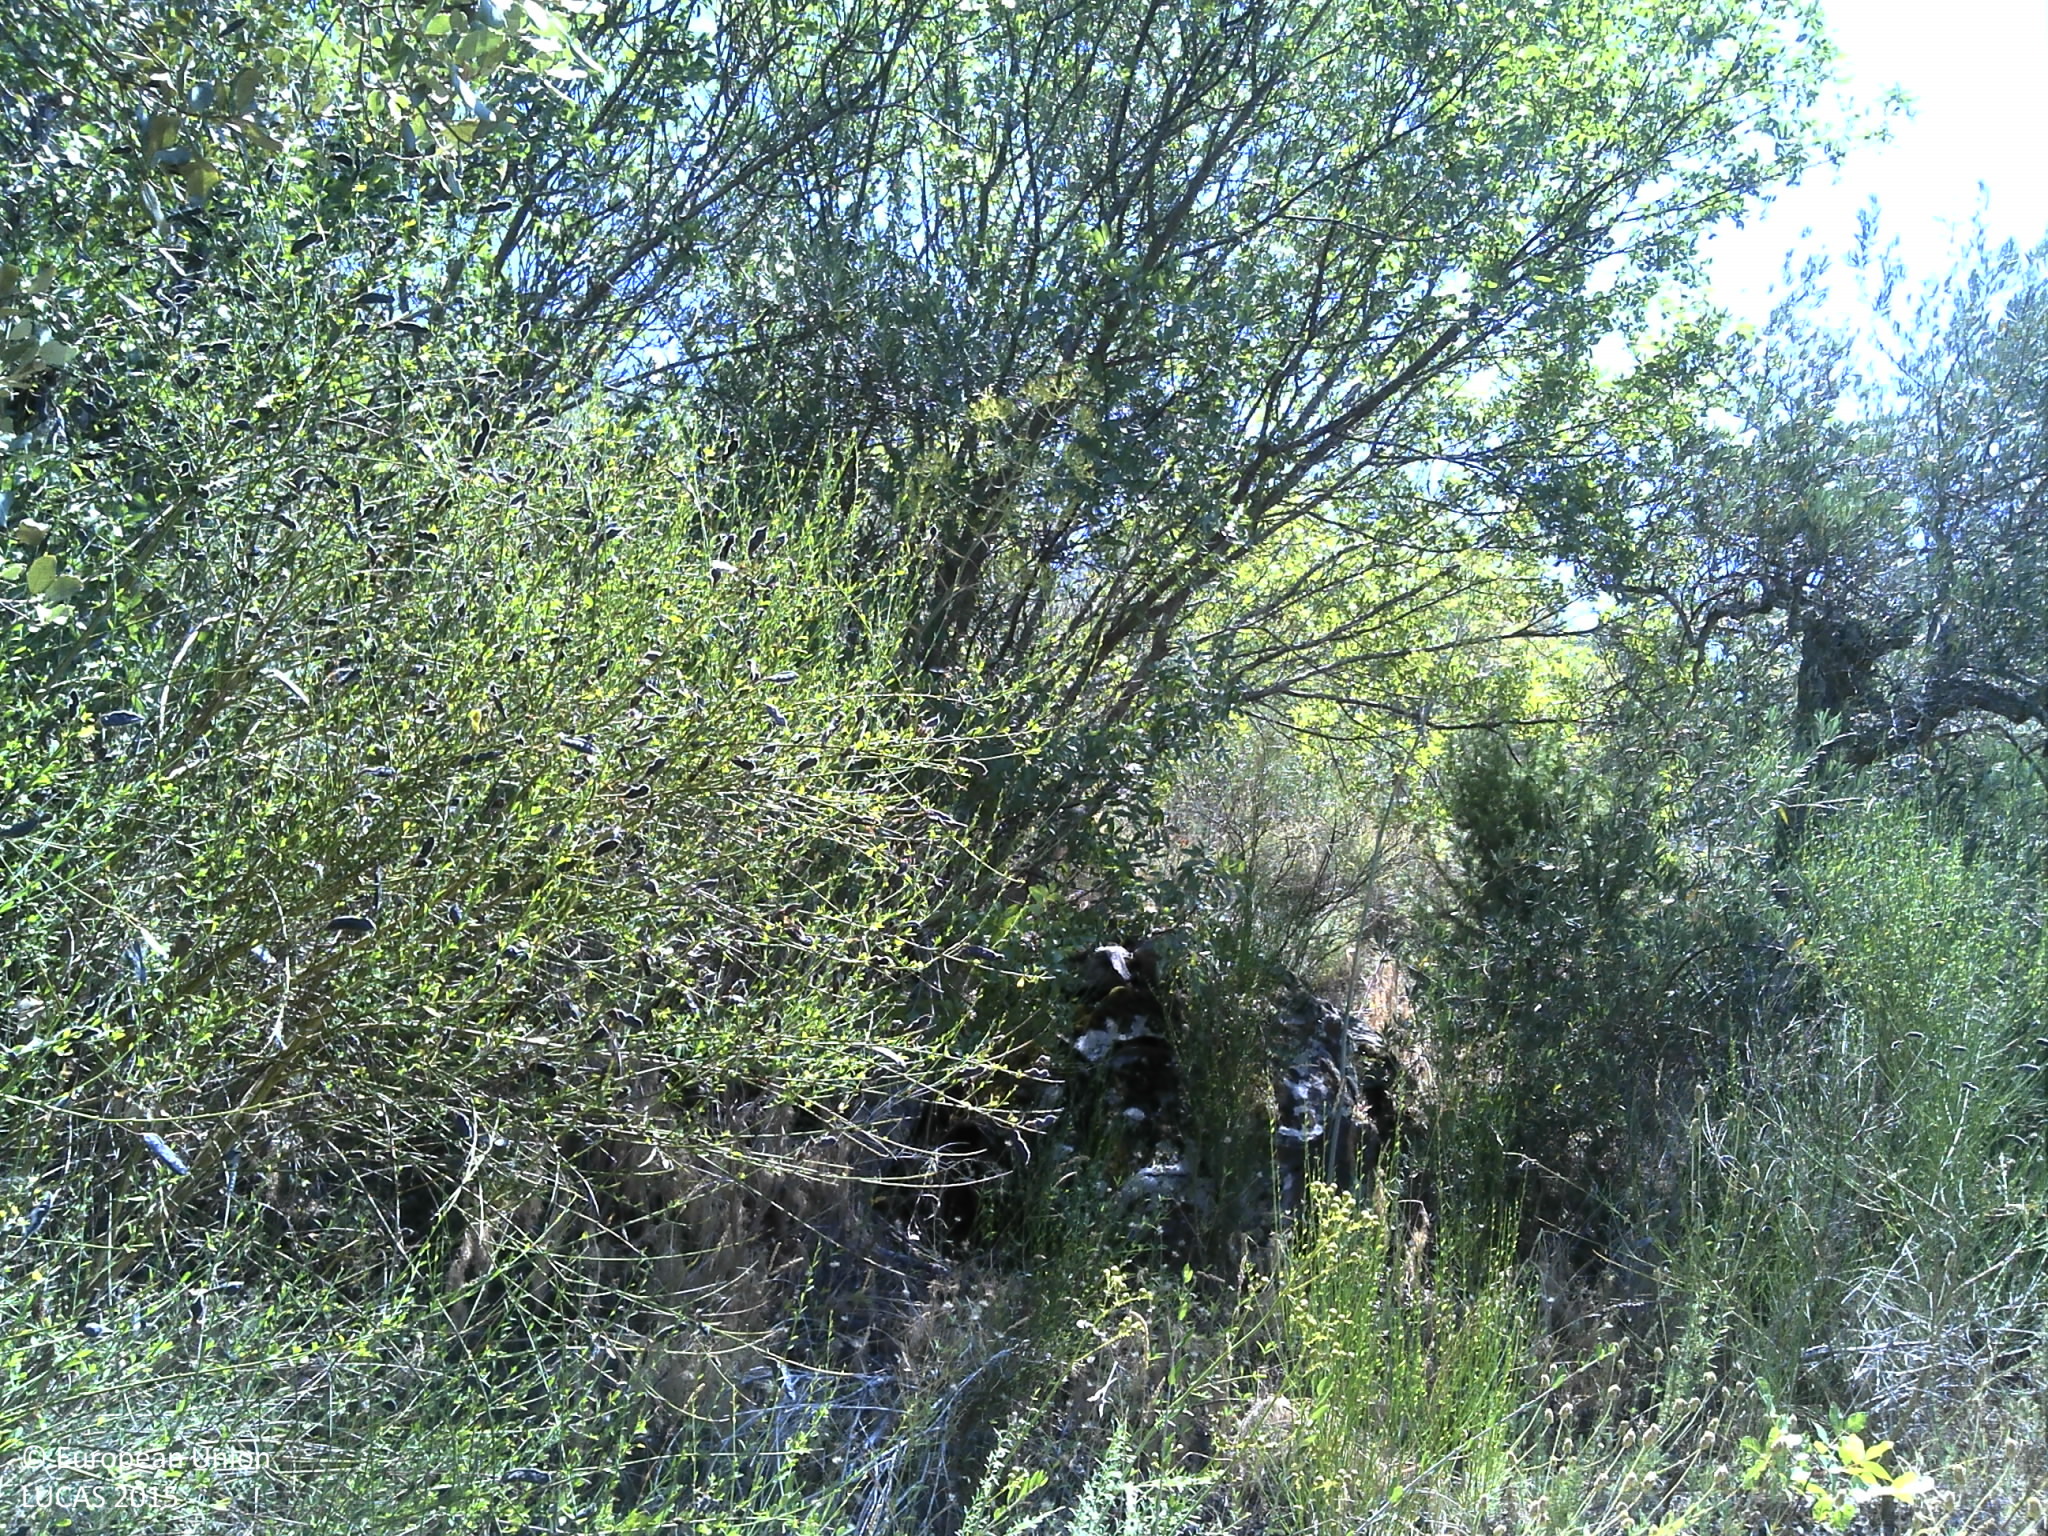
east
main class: Shrubland
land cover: Shrubland with sparse tree cover
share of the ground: 50 - 75 %
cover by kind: shrubs 75 %, unconsolidated bare surface 15 %, broadleaved forest trees 5 %, herbaceous plants 5 %
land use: Abandoned areas
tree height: > 5 m
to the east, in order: Shrubland with sparse tree cover; Dry stone walls; Shrubland with sparse tree cover; Nuts trees; Groves; Nuts trees; Tracks; Nuts trees; Tracks; Abandoned hedges; Olive groves; Dry stone walls; Olive groves; Dry stone walls; Nuts trees
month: June
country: PT
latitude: 41.2880
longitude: -6.8362
